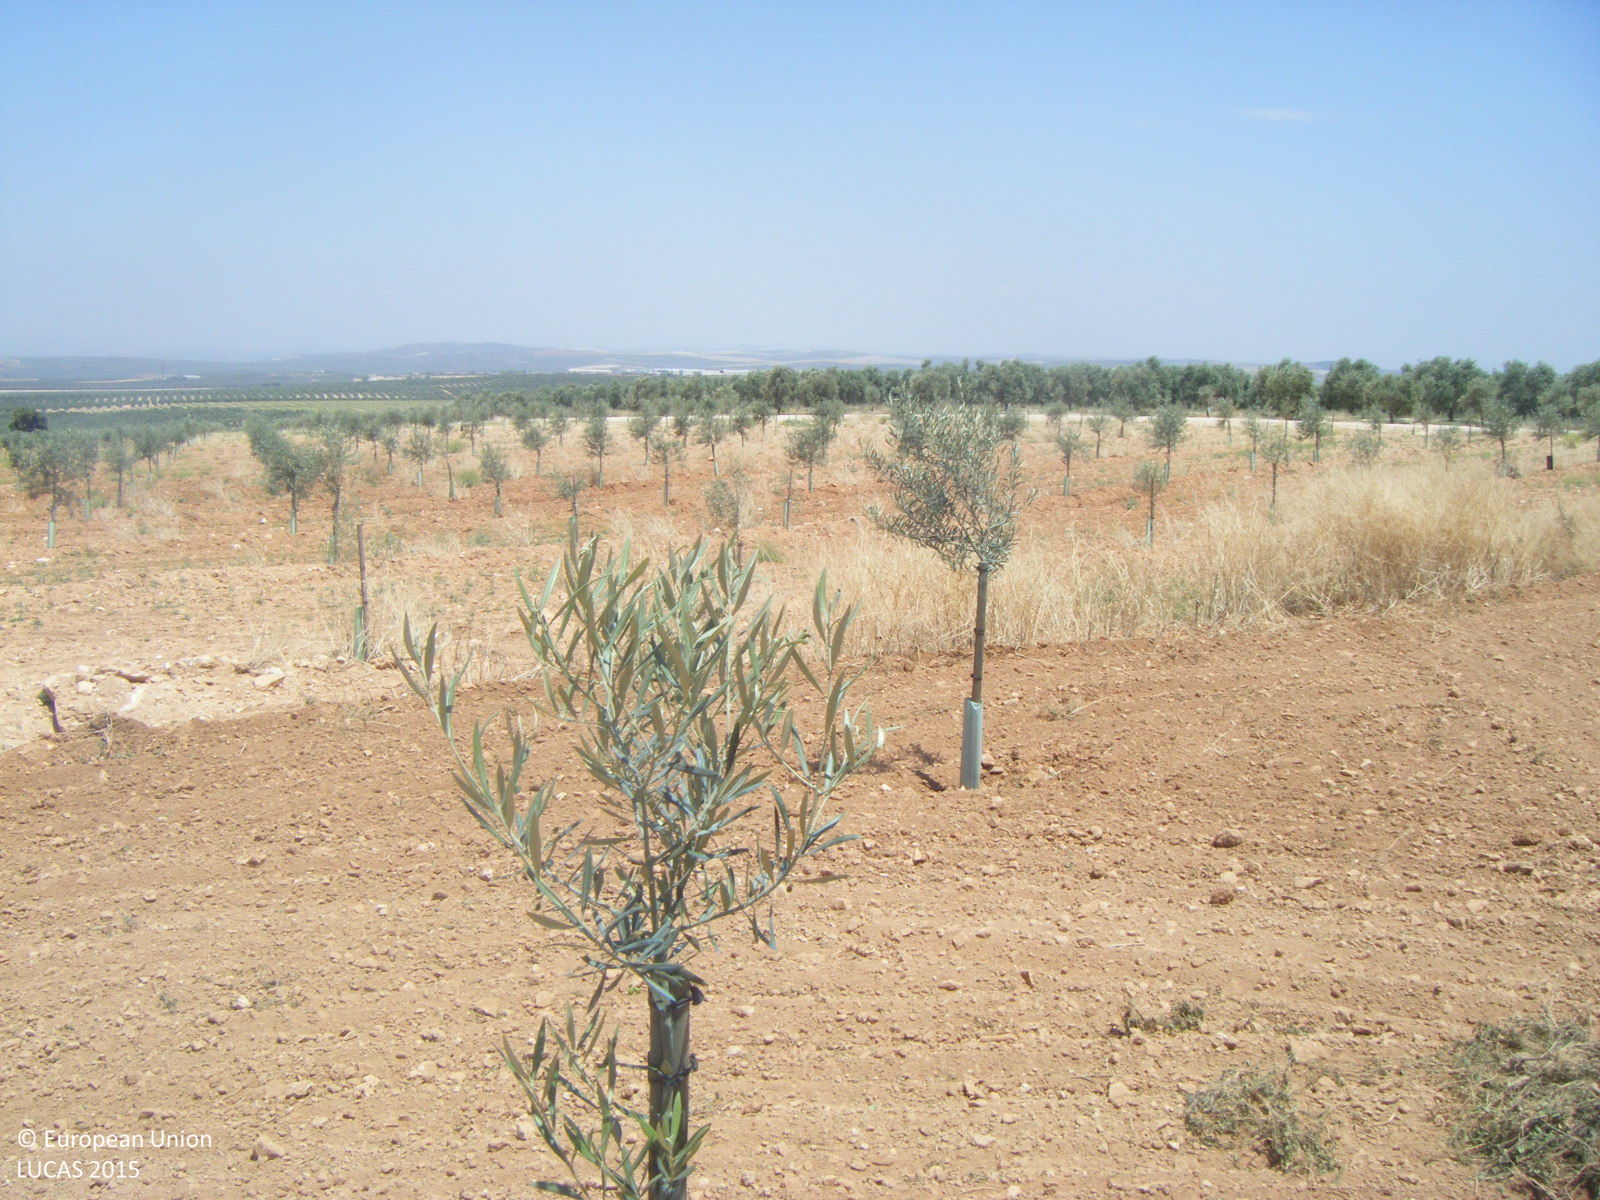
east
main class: Cropland
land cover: Olive groves
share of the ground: < 10 %
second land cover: Other bare soil
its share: > 75 %
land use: Agriculture (excluding fallow land and kitchen gardens)
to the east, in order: Olive groves; Other bare soil; Grass margins; Olive groves; Tracks; Olive groves
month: May
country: ES
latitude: 37.2796
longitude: -4.8130
